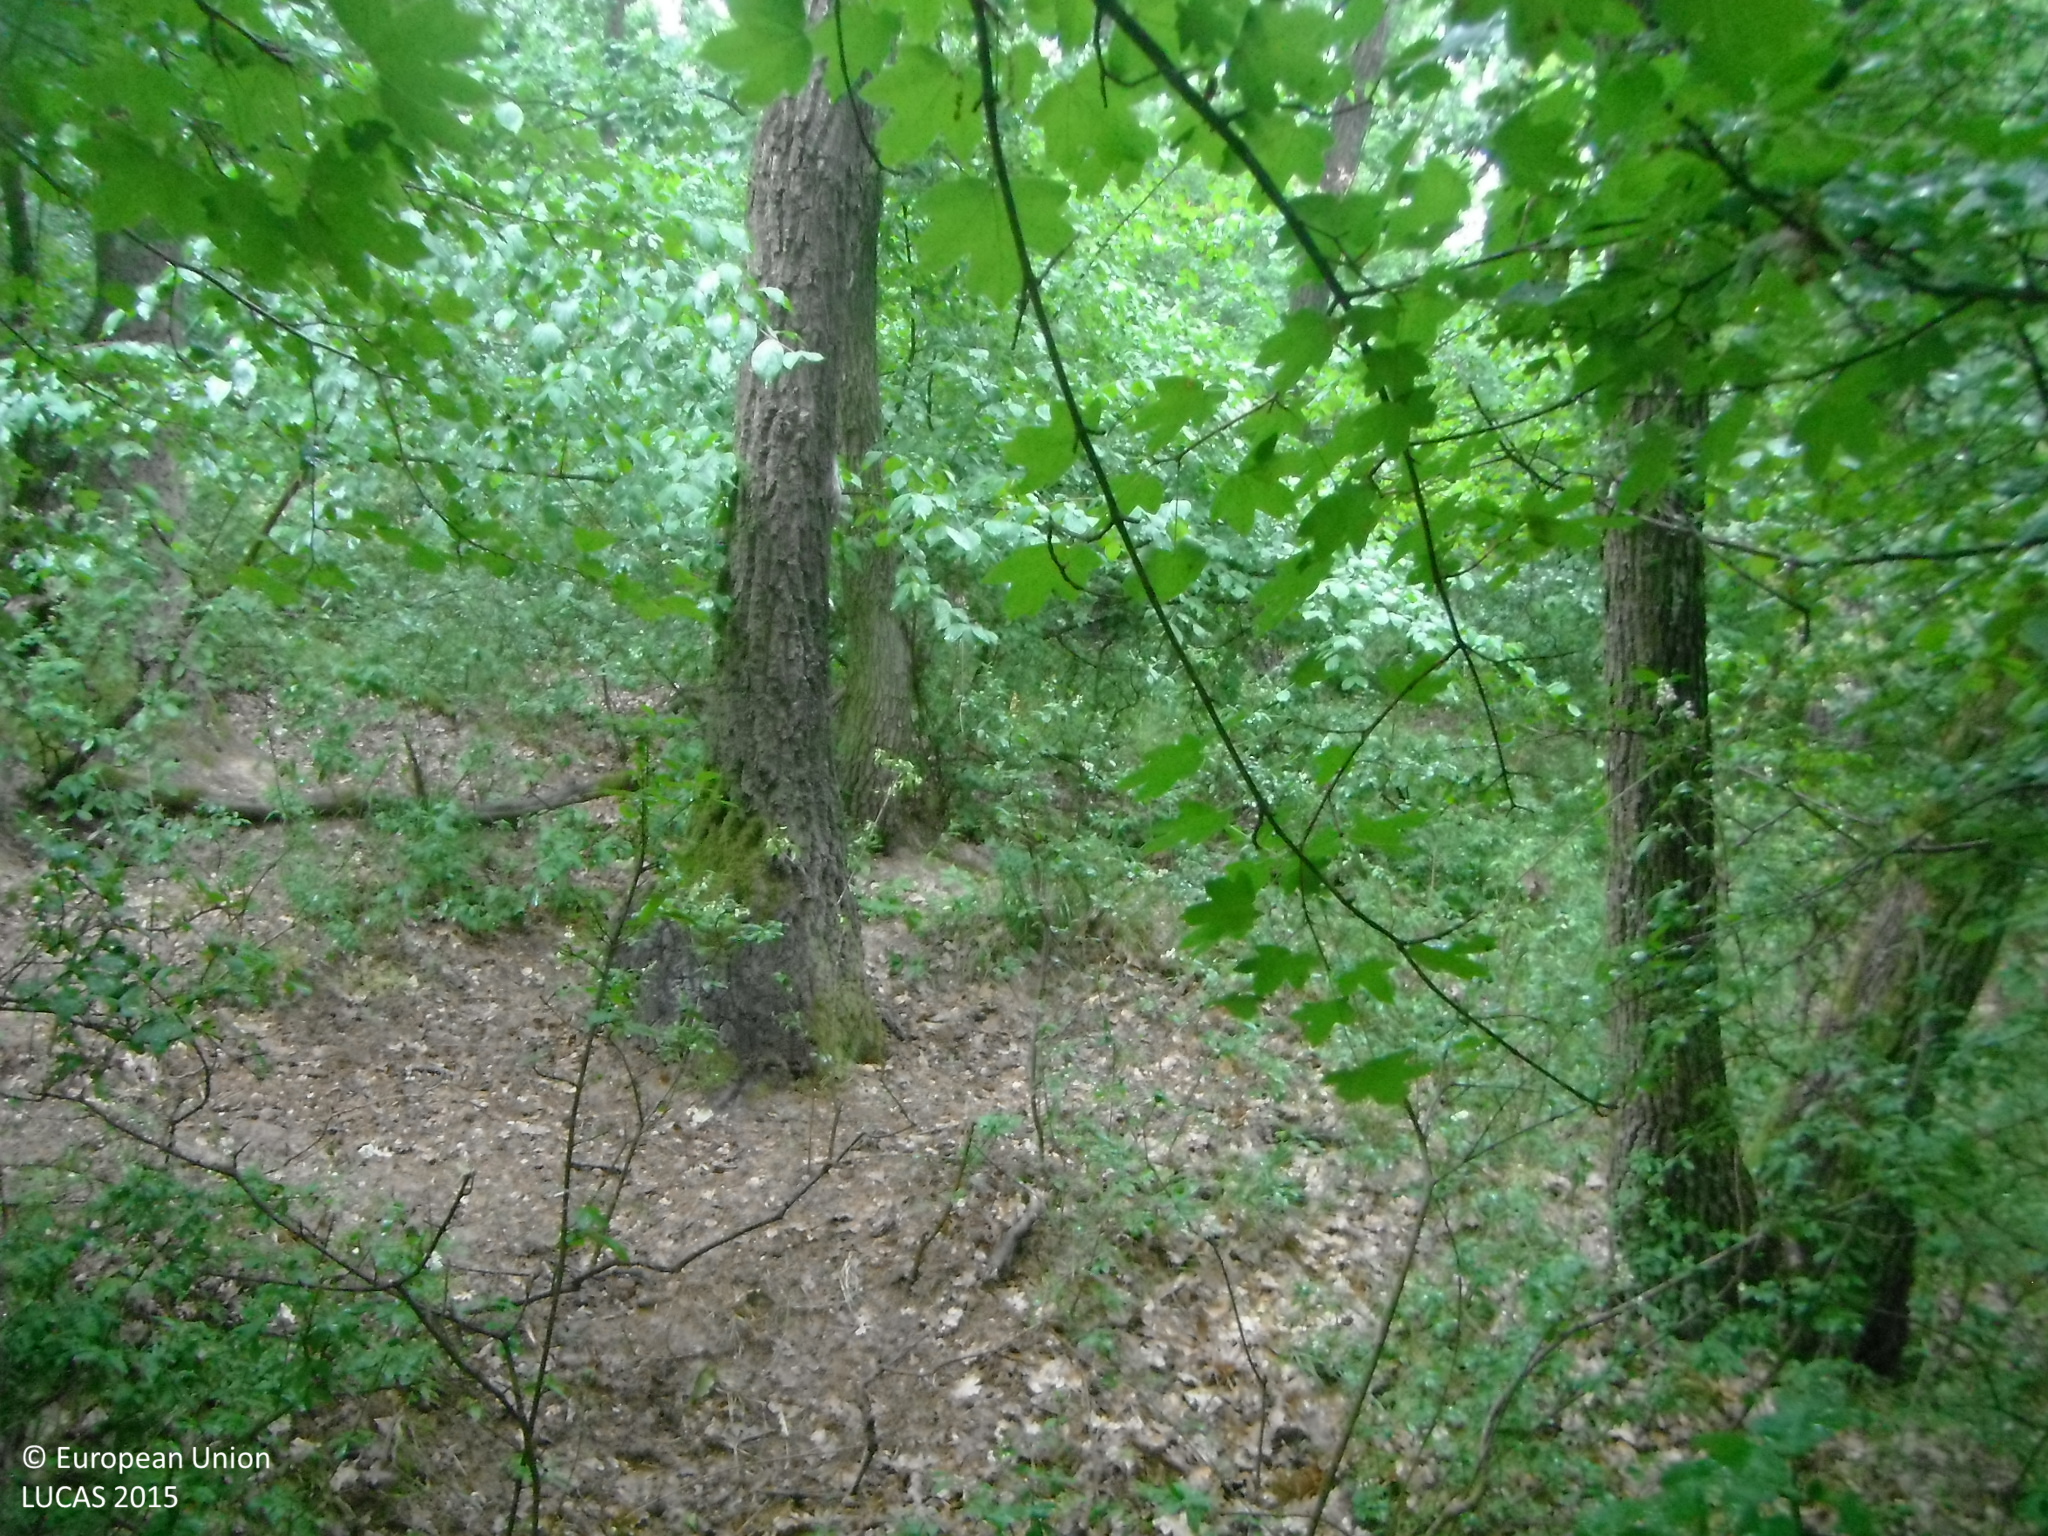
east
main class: Woodland
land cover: Broadleaved woodland
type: mesophytic deciduous forest
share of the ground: > 75 %
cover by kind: broadleaved forest trees 85 %, herbaceous plants 10 %, shrubs 5 %
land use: Forestry
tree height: > 5 m
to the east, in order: Broadleaved woodland
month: June
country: SK
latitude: 48.7204
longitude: 18.3486
